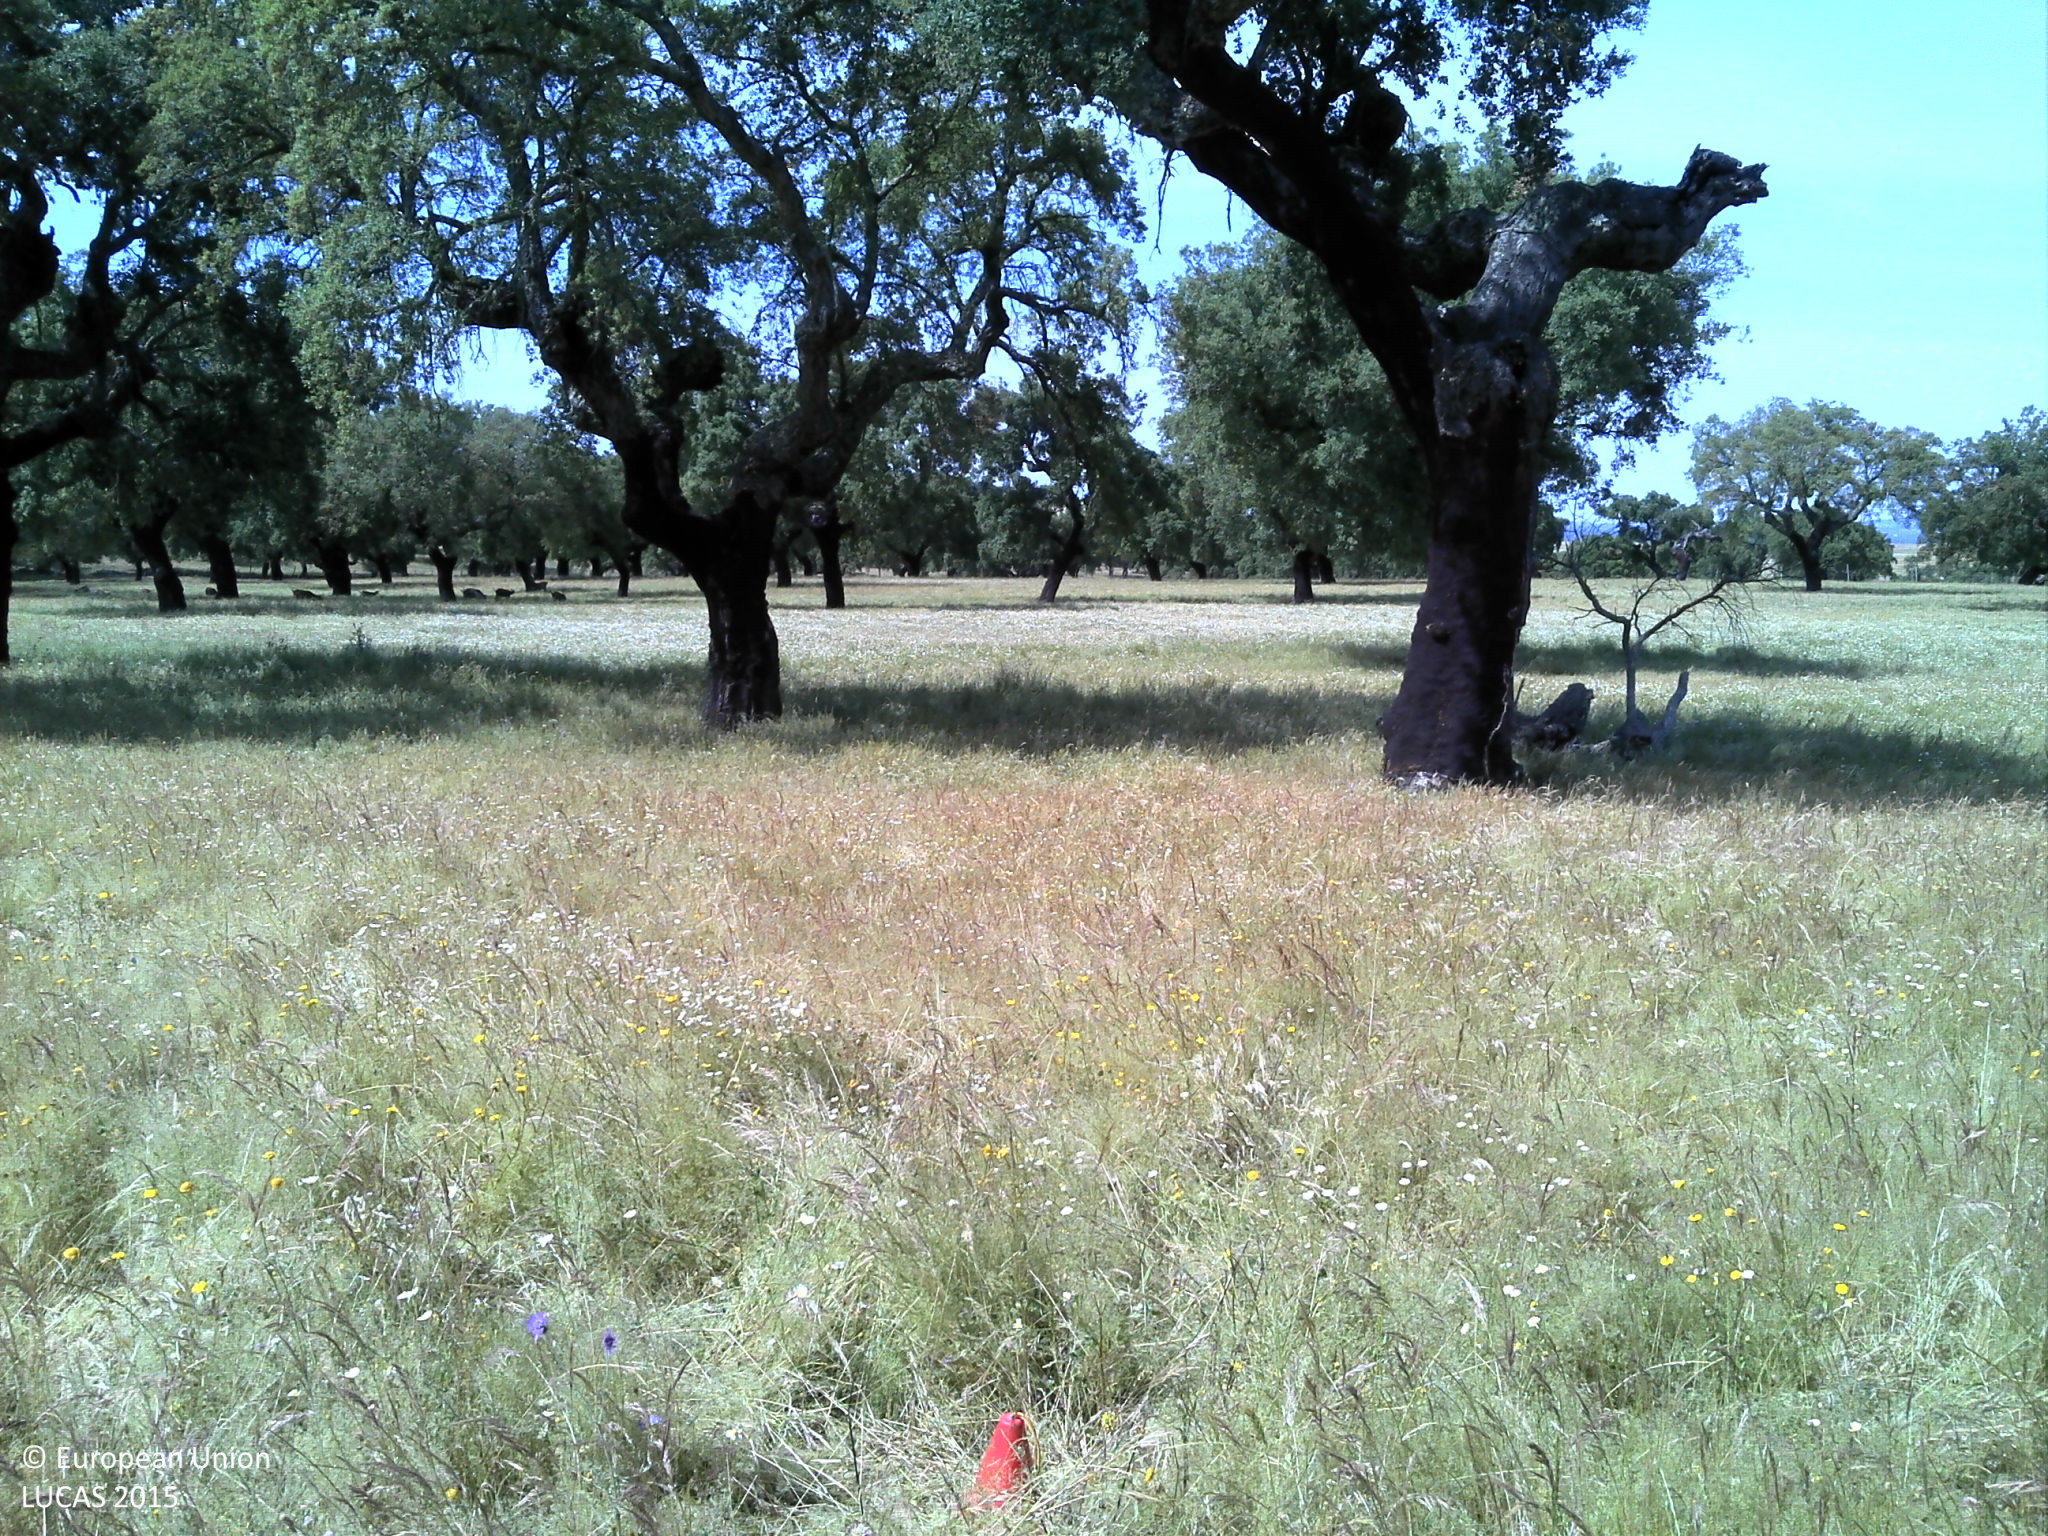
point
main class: Woodland
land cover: Broadleaved woodland
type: broadleaved evergreen forest
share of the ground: 25 - 50 %
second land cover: Grassland without tree/shrub cover
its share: 50 - 75 %
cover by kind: herbaceous plants 50 %, broadleaved forest trees 40 %, unconsolidated bare surface 10 %
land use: Forestry
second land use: Agriculture (excluding fallow land and kitchen gardens)
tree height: > 5 m
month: May
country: PT
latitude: 39.2094
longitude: -7.6362
